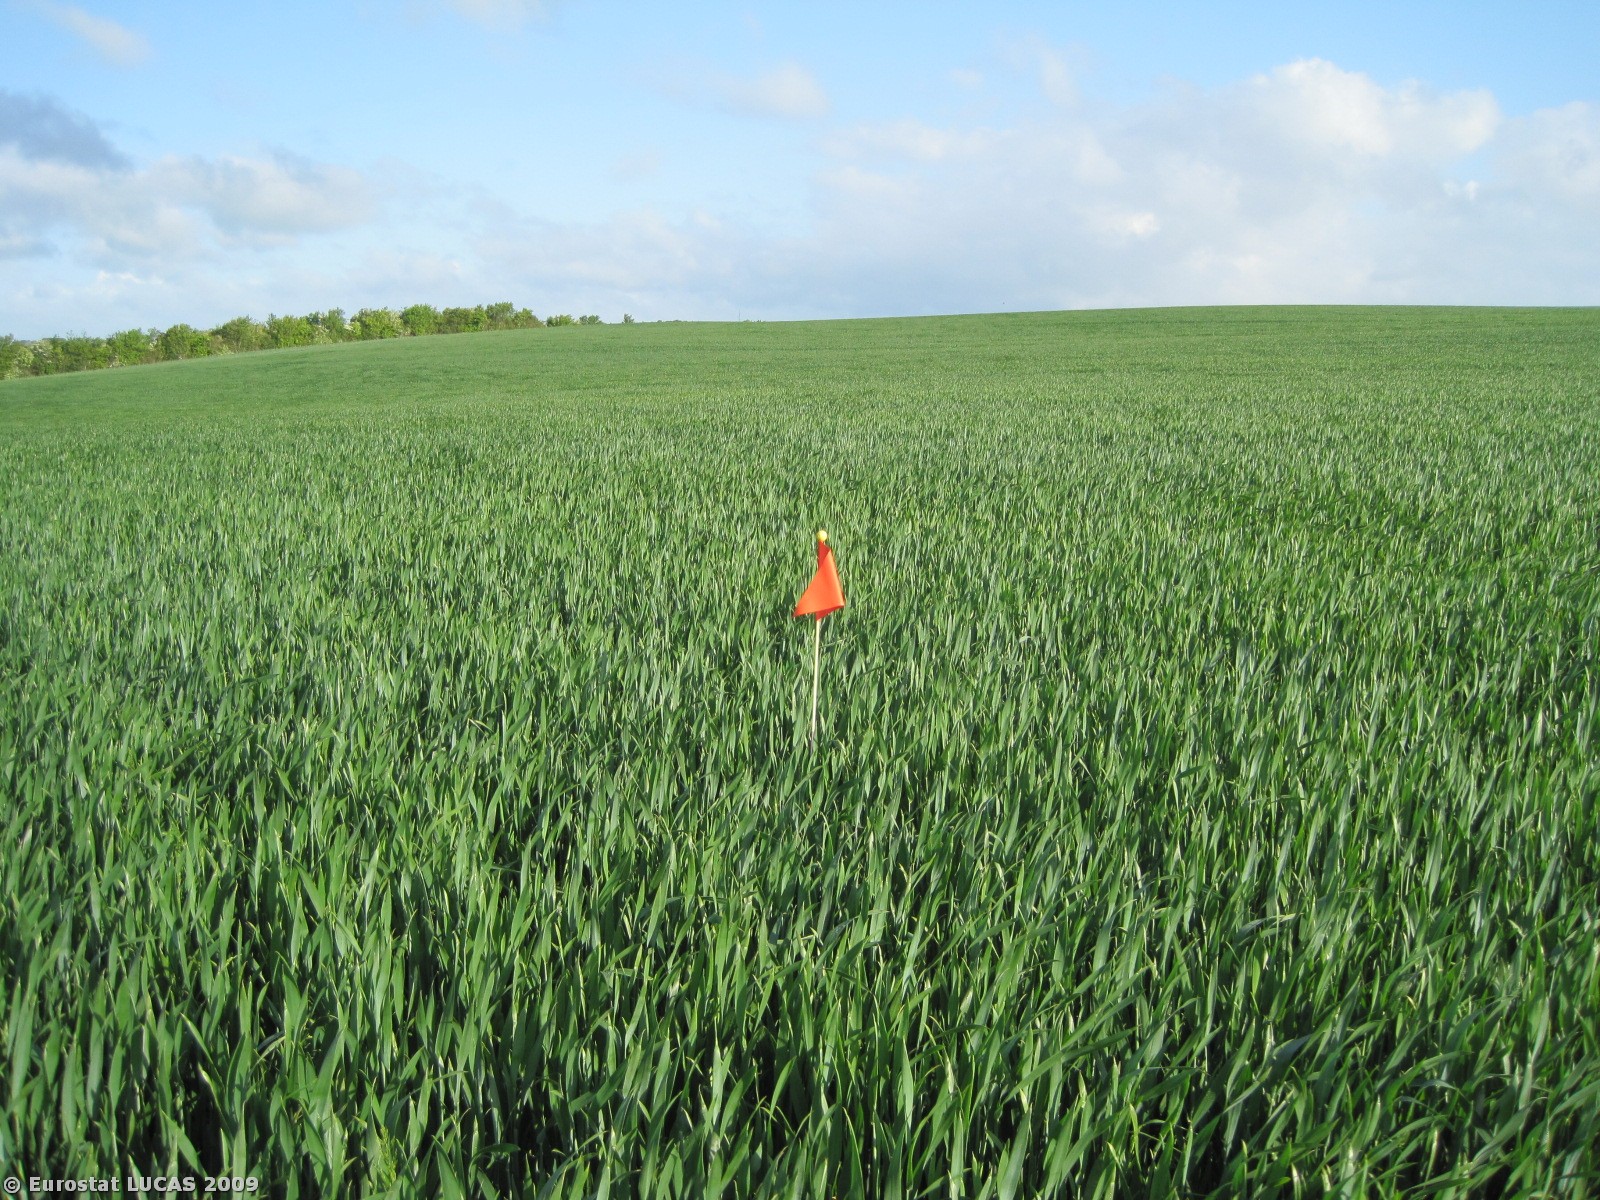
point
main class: Cropland
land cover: Common wheat
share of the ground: > 75 %
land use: Agriculture (excluding fallow land and kitchen gardens)
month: May
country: DK
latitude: 56.5472
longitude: 10.0812
